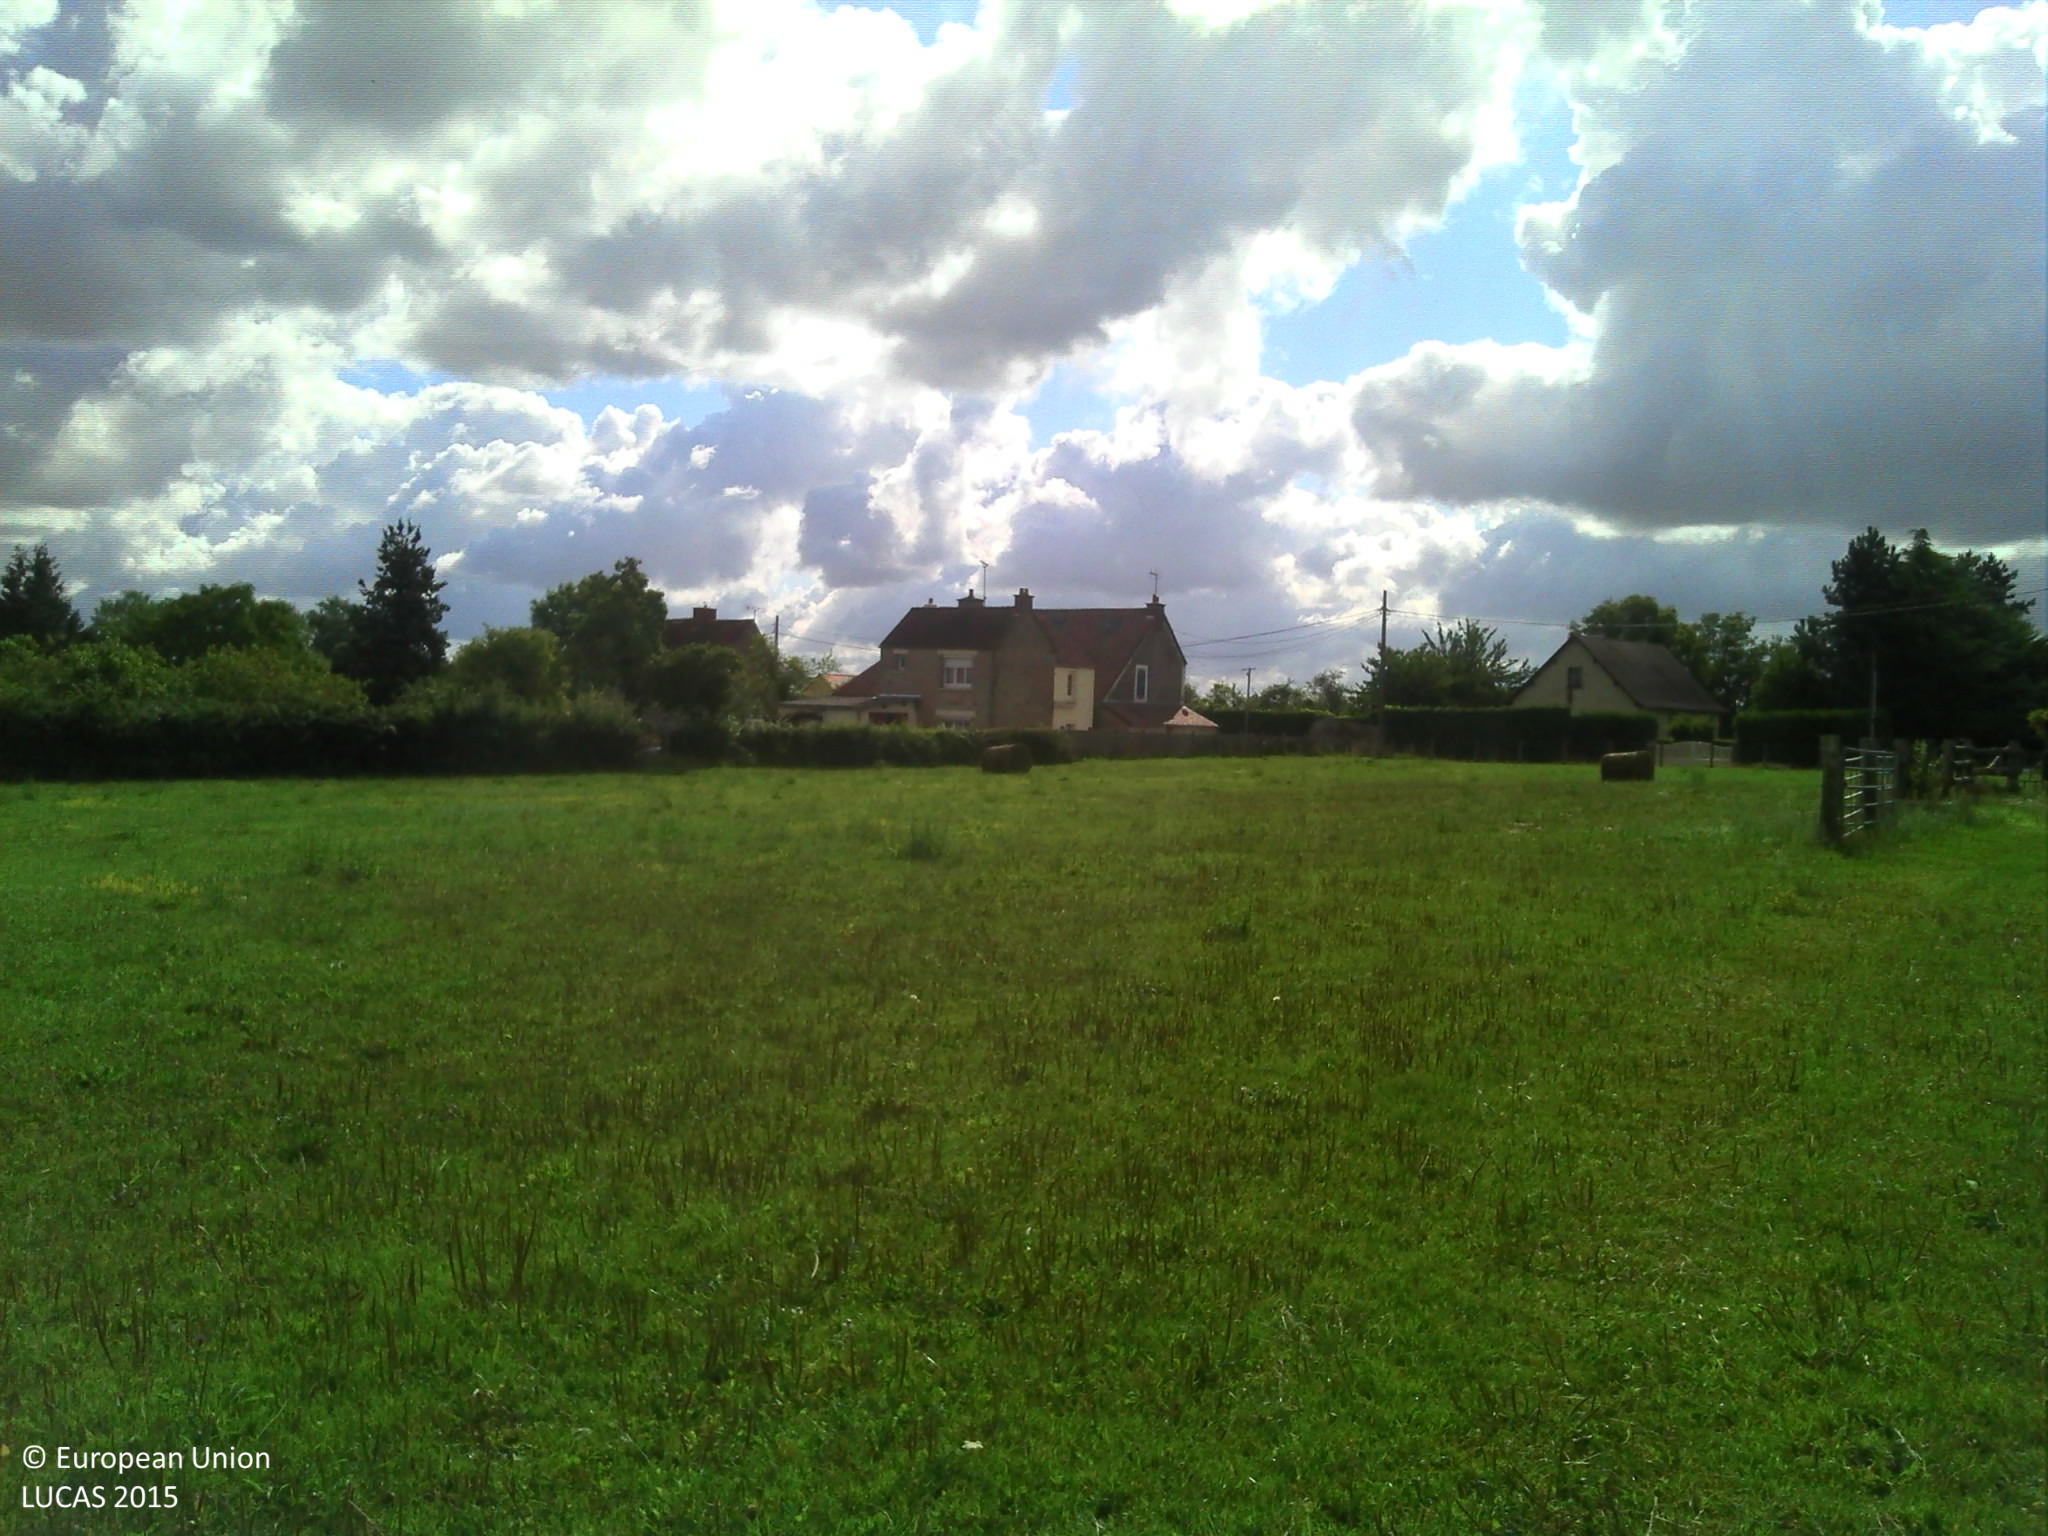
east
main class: Grassland
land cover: Grassland without tree/shrub cover
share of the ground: > 75 %
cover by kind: herbaceous plants 100 %
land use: Agriculture (excluding fallow land and kitchen gardens)
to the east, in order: Grassland without tree/shrub cover; Artificial constructions in urban areas
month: July
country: FR
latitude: 48.8769
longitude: -0.1631
